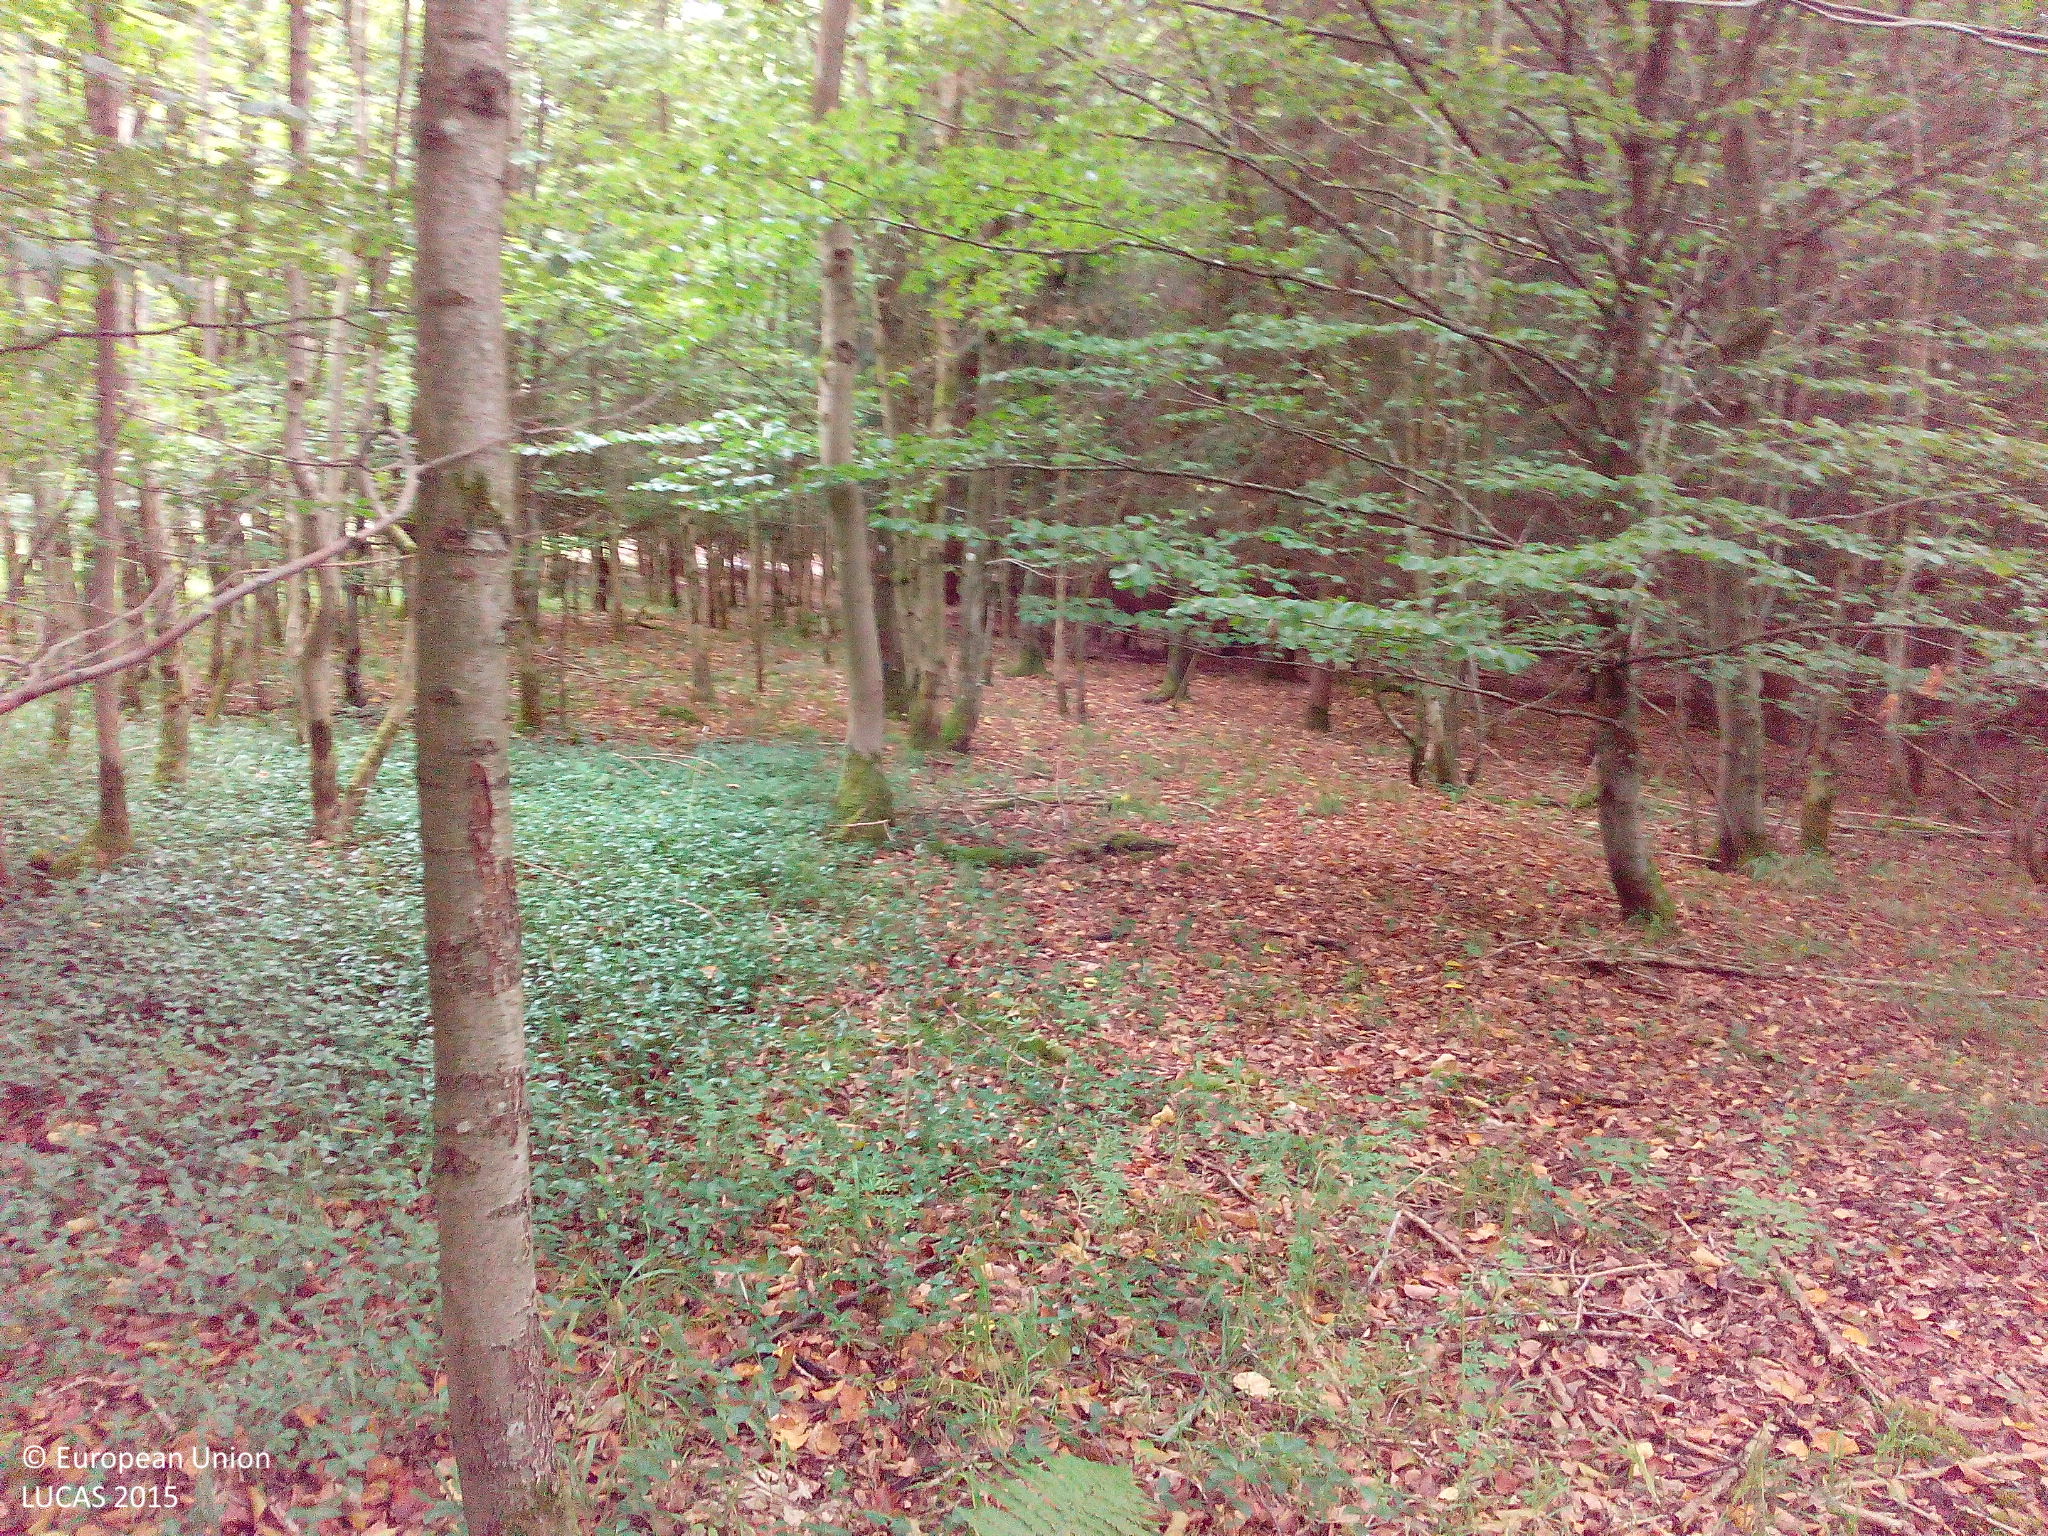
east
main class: Woodland
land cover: Broadleaved woodland
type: beech forest
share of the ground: > 75 %
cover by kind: broadleaved forest trees 100 %
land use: Forestry
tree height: > 5 m
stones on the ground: < 10 %
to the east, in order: Broadleaved woodland; Spruce dominated coniferous woodland; Grassland without tree/shrub cover; Broadleaved woodland; Grass margins; Broadleaved woodland
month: August
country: DE
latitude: 50.6317
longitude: 9.3075
